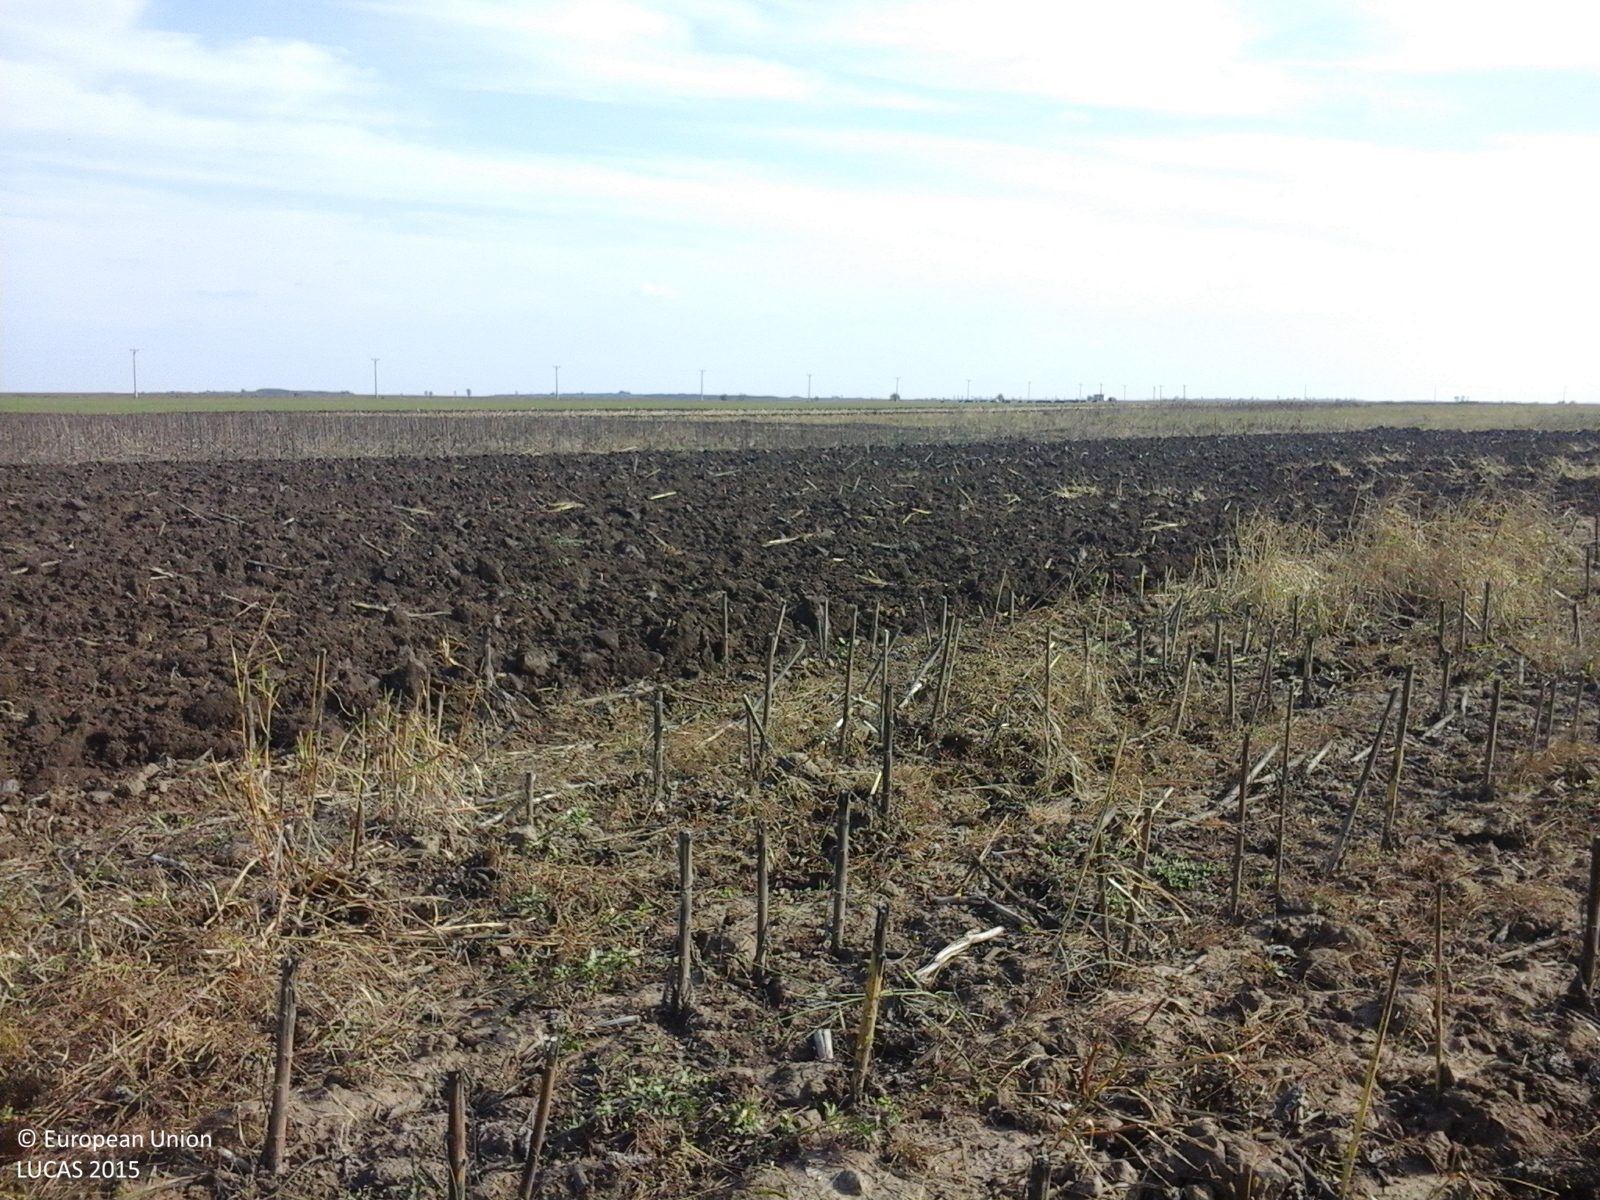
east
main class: Cropland
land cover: Sunflower
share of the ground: 10 - 25 %
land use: Agriculture (excluding fallow land and kitchen gardens)
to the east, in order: Sunflower; Grass margins; Tracks; Grass margins; Sunflower; Maize; Other bare soil
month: October
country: RO
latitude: 45.1957
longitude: 27.2382
